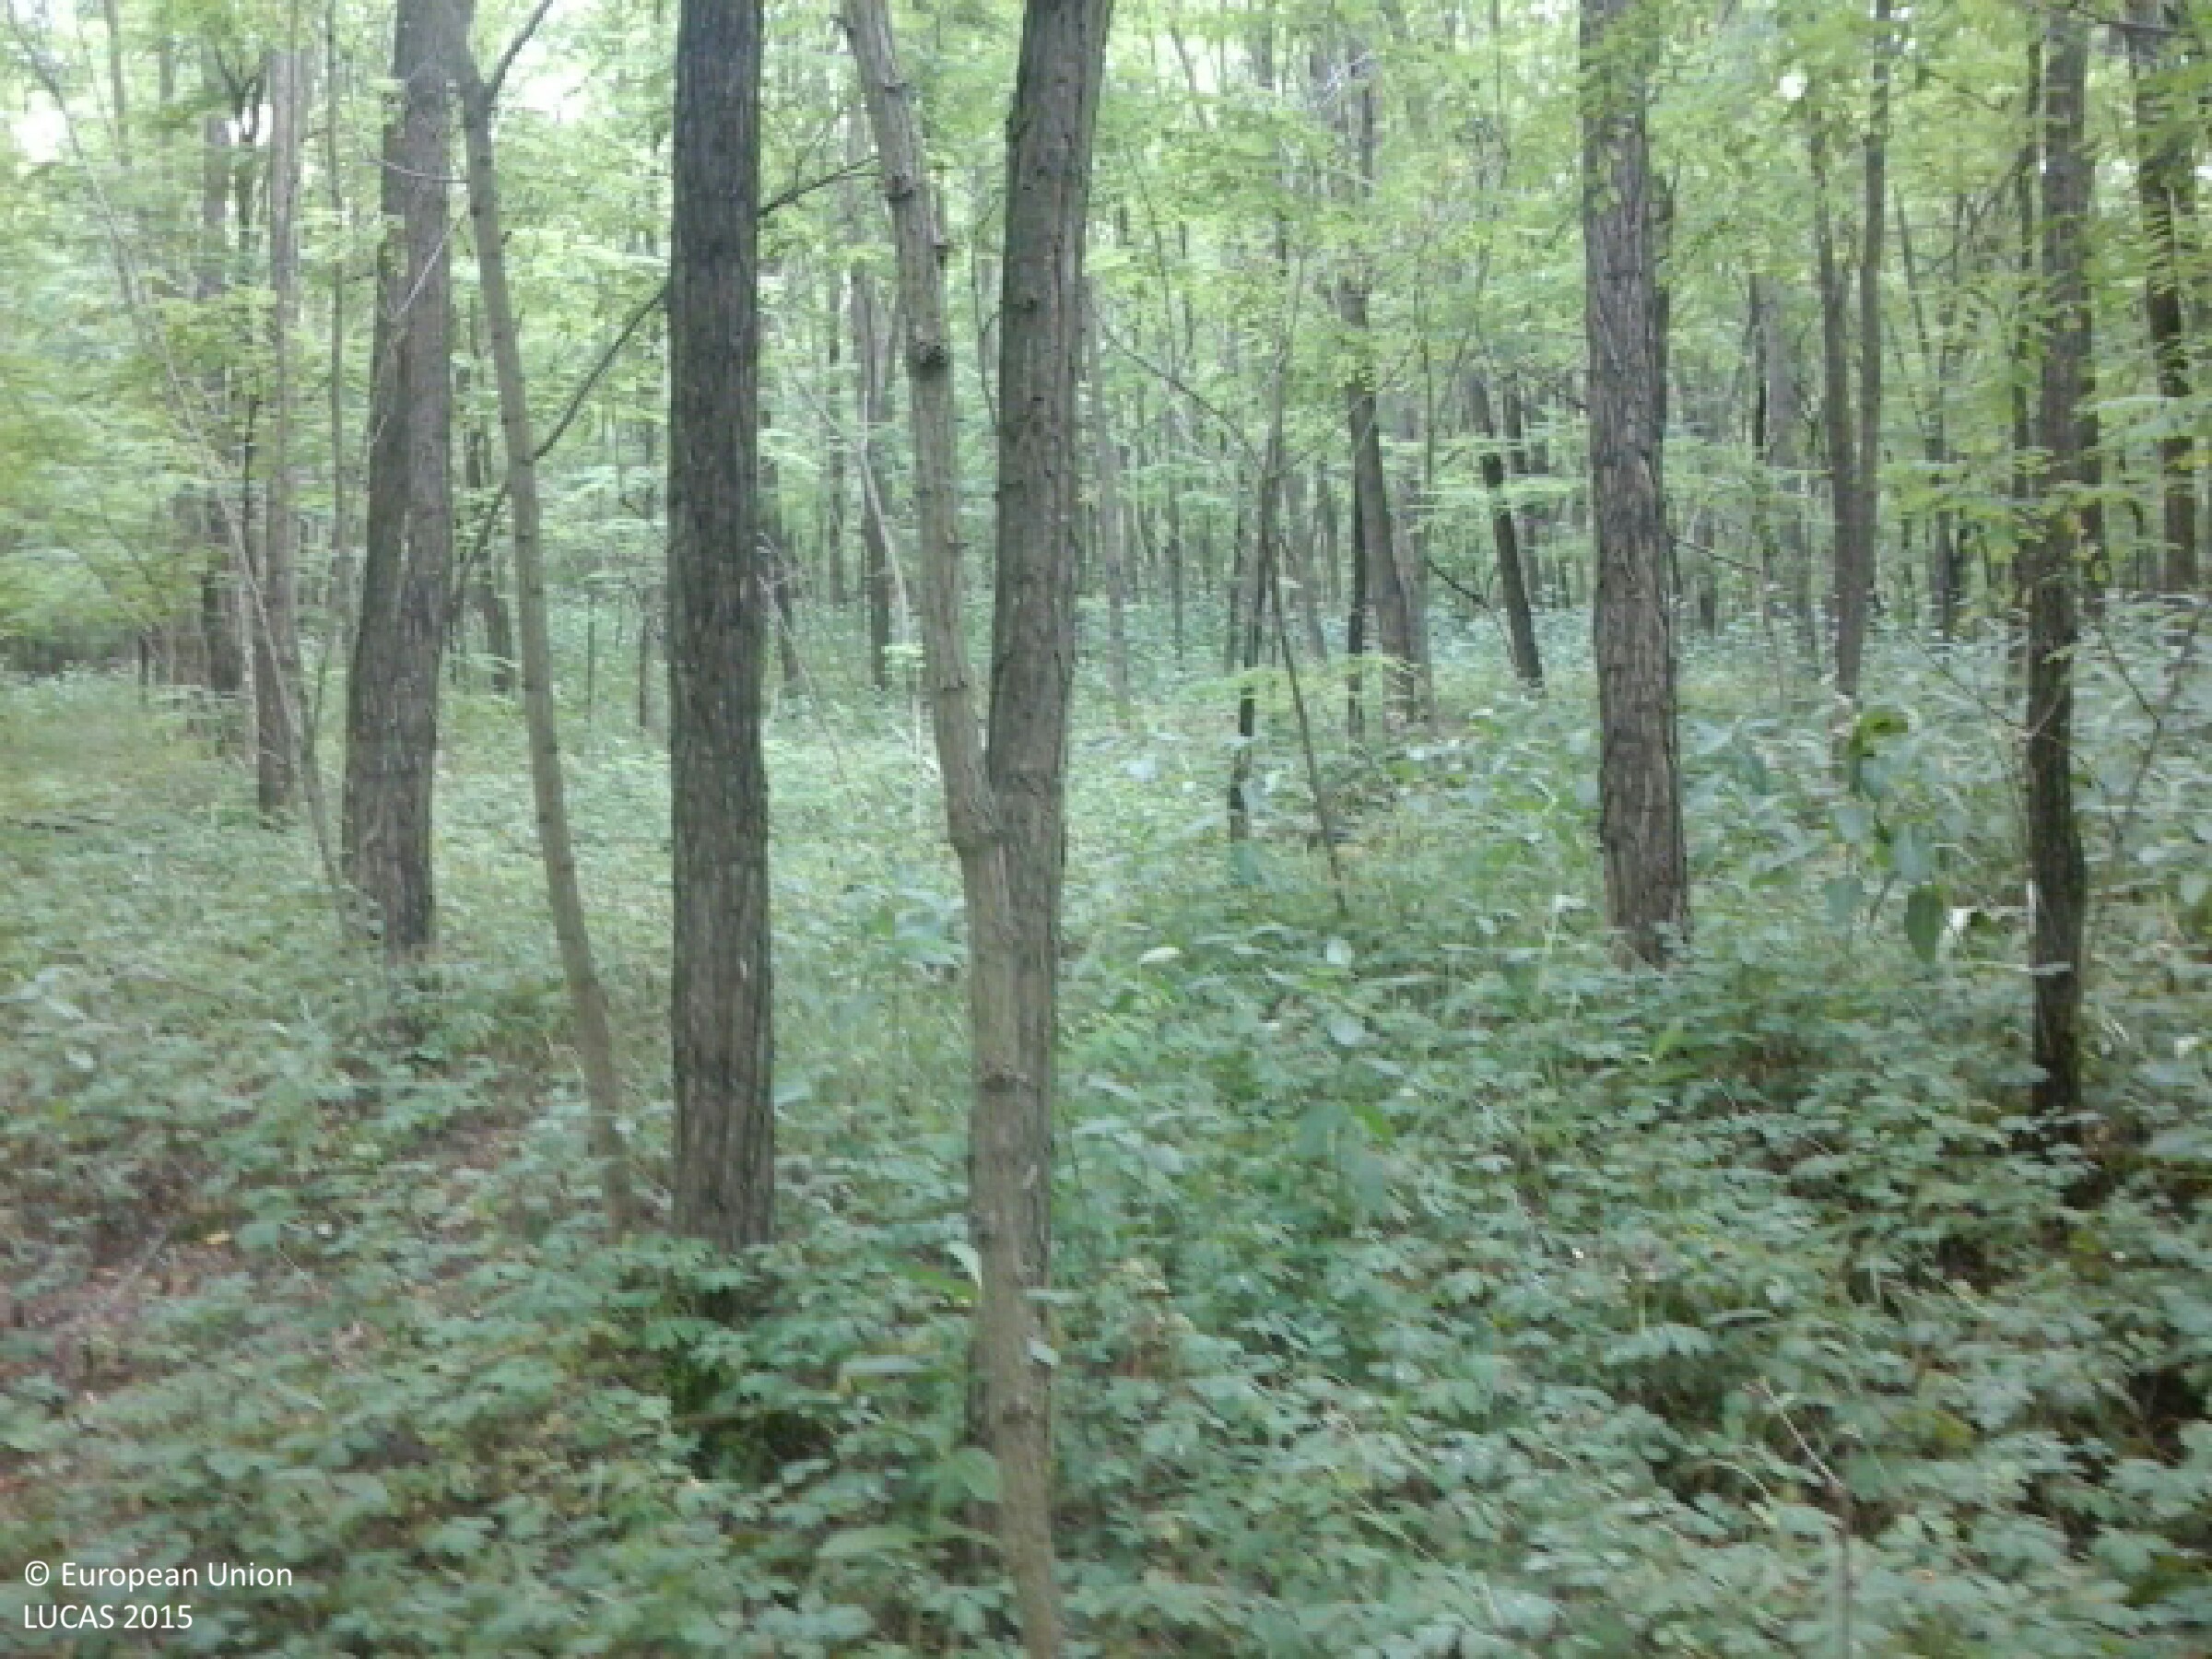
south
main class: Woodland
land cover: Broadleaved woodland
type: exotic forest
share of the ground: > 75 %
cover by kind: broadleaved forest trees 80 %, herbaceous plants 15 %, shrubs 5 %
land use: Forestry
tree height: > 5 m
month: June
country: HU
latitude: 48.1060
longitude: 22.2098
